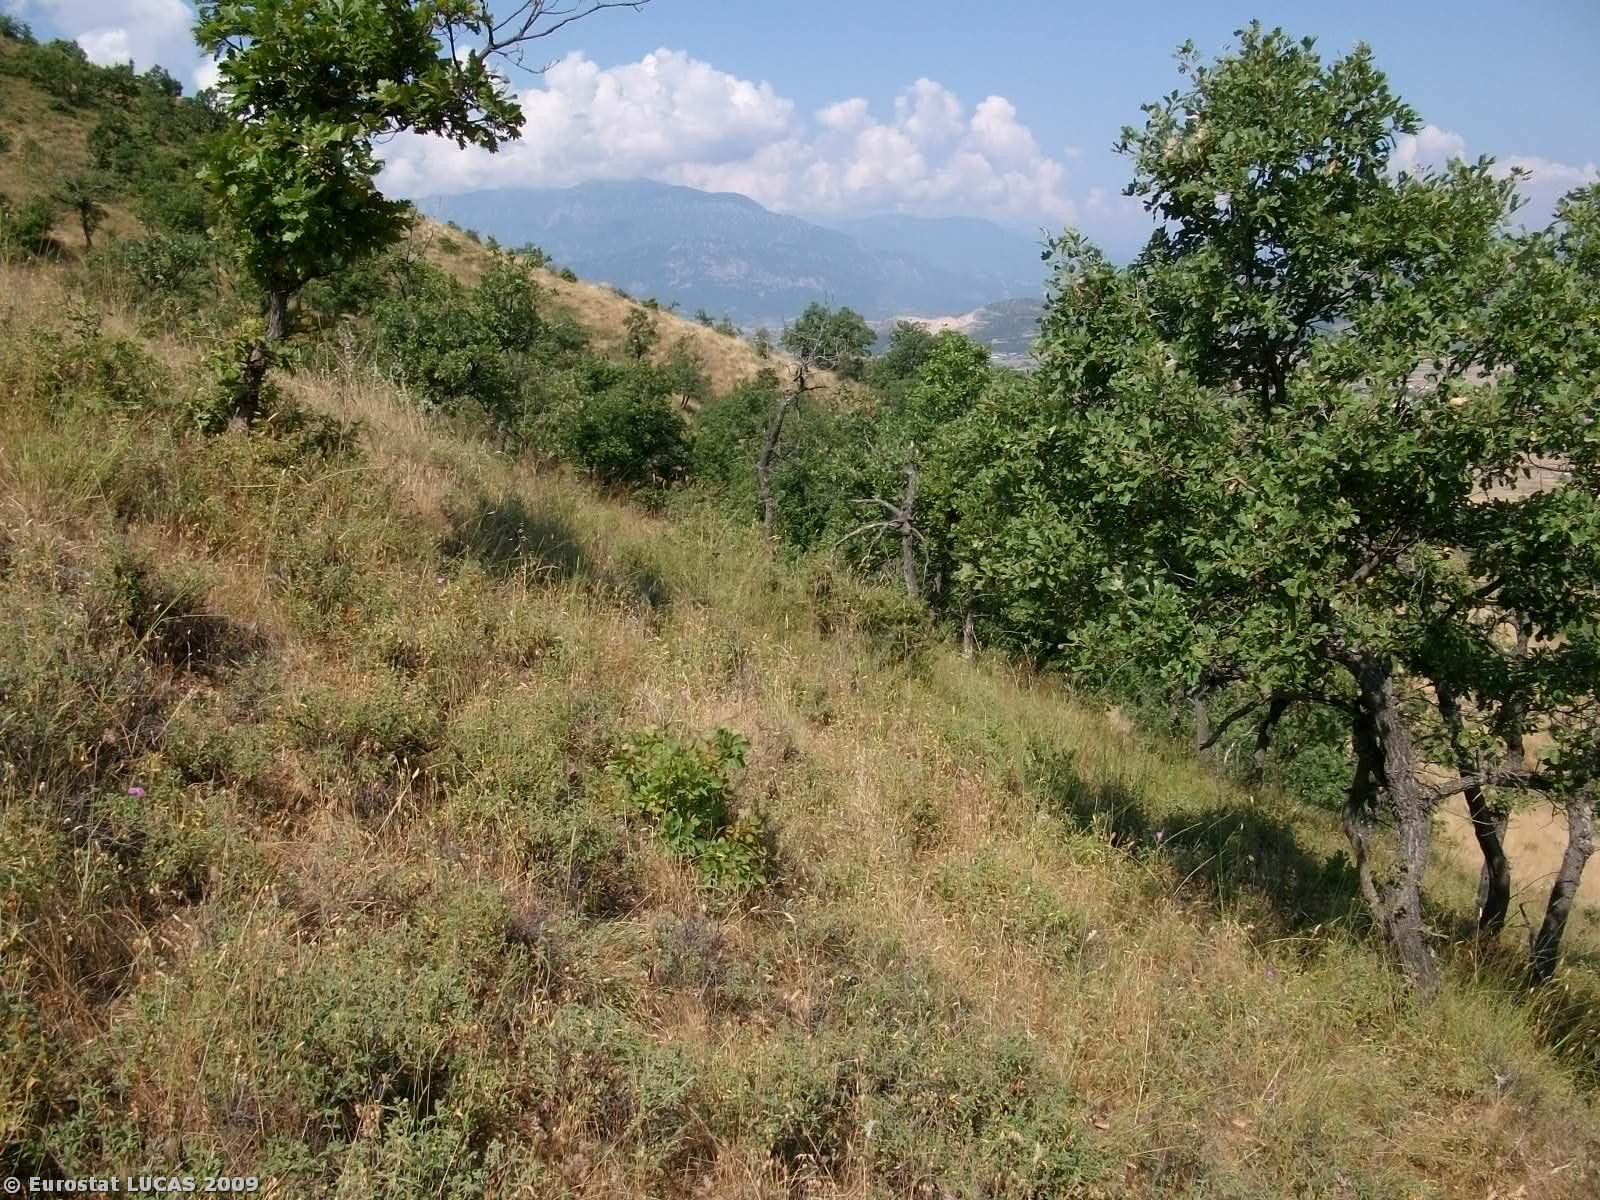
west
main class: Grassland
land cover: Grassland with sparse tree/shrub cover
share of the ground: > 75 %
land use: Agriculture (excluding fallow land and kitchen gardens)
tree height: < 5 m
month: July
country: GR
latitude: 39.6893
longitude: 21.7268
